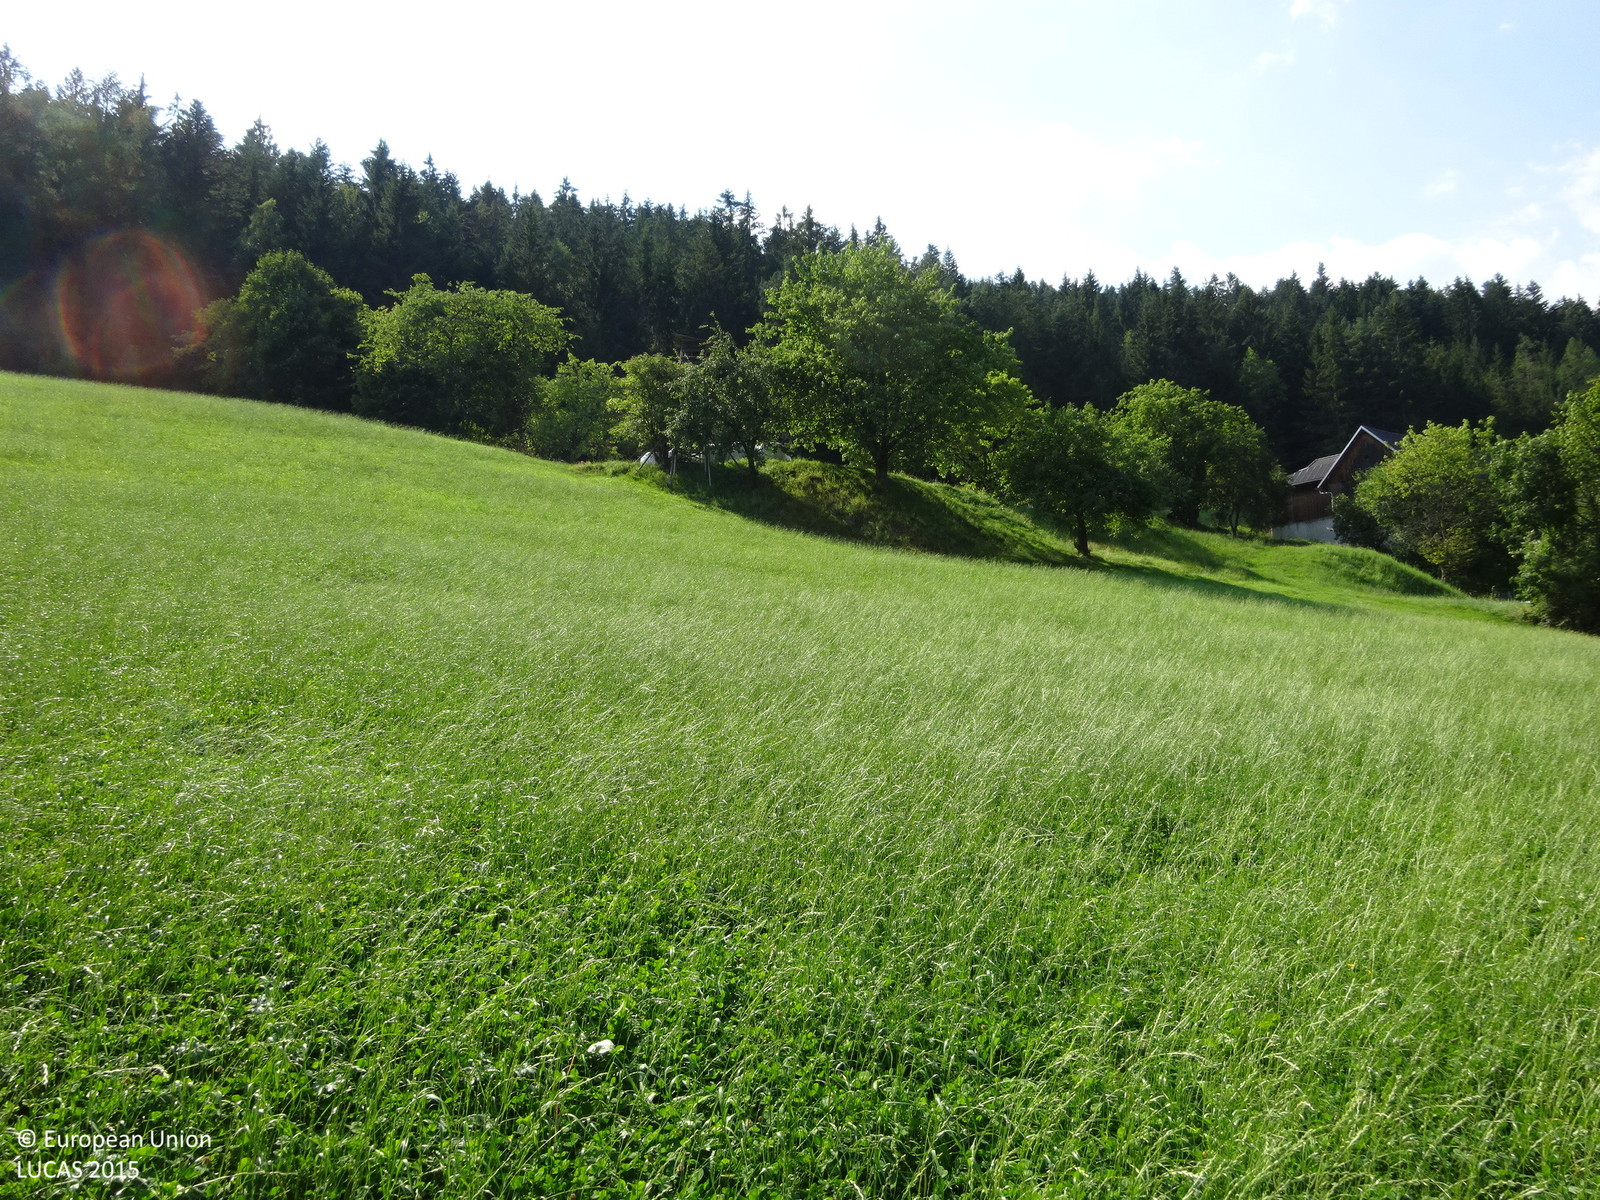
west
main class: Grassland
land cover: Grassland without tree/shrub cover
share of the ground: > 75 %
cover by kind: herbaceous plants 100 %
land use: Agriculture (excluding fallow land and kitchen gardens)
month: August
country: AT
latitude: 47.4272
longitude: 15.6884
